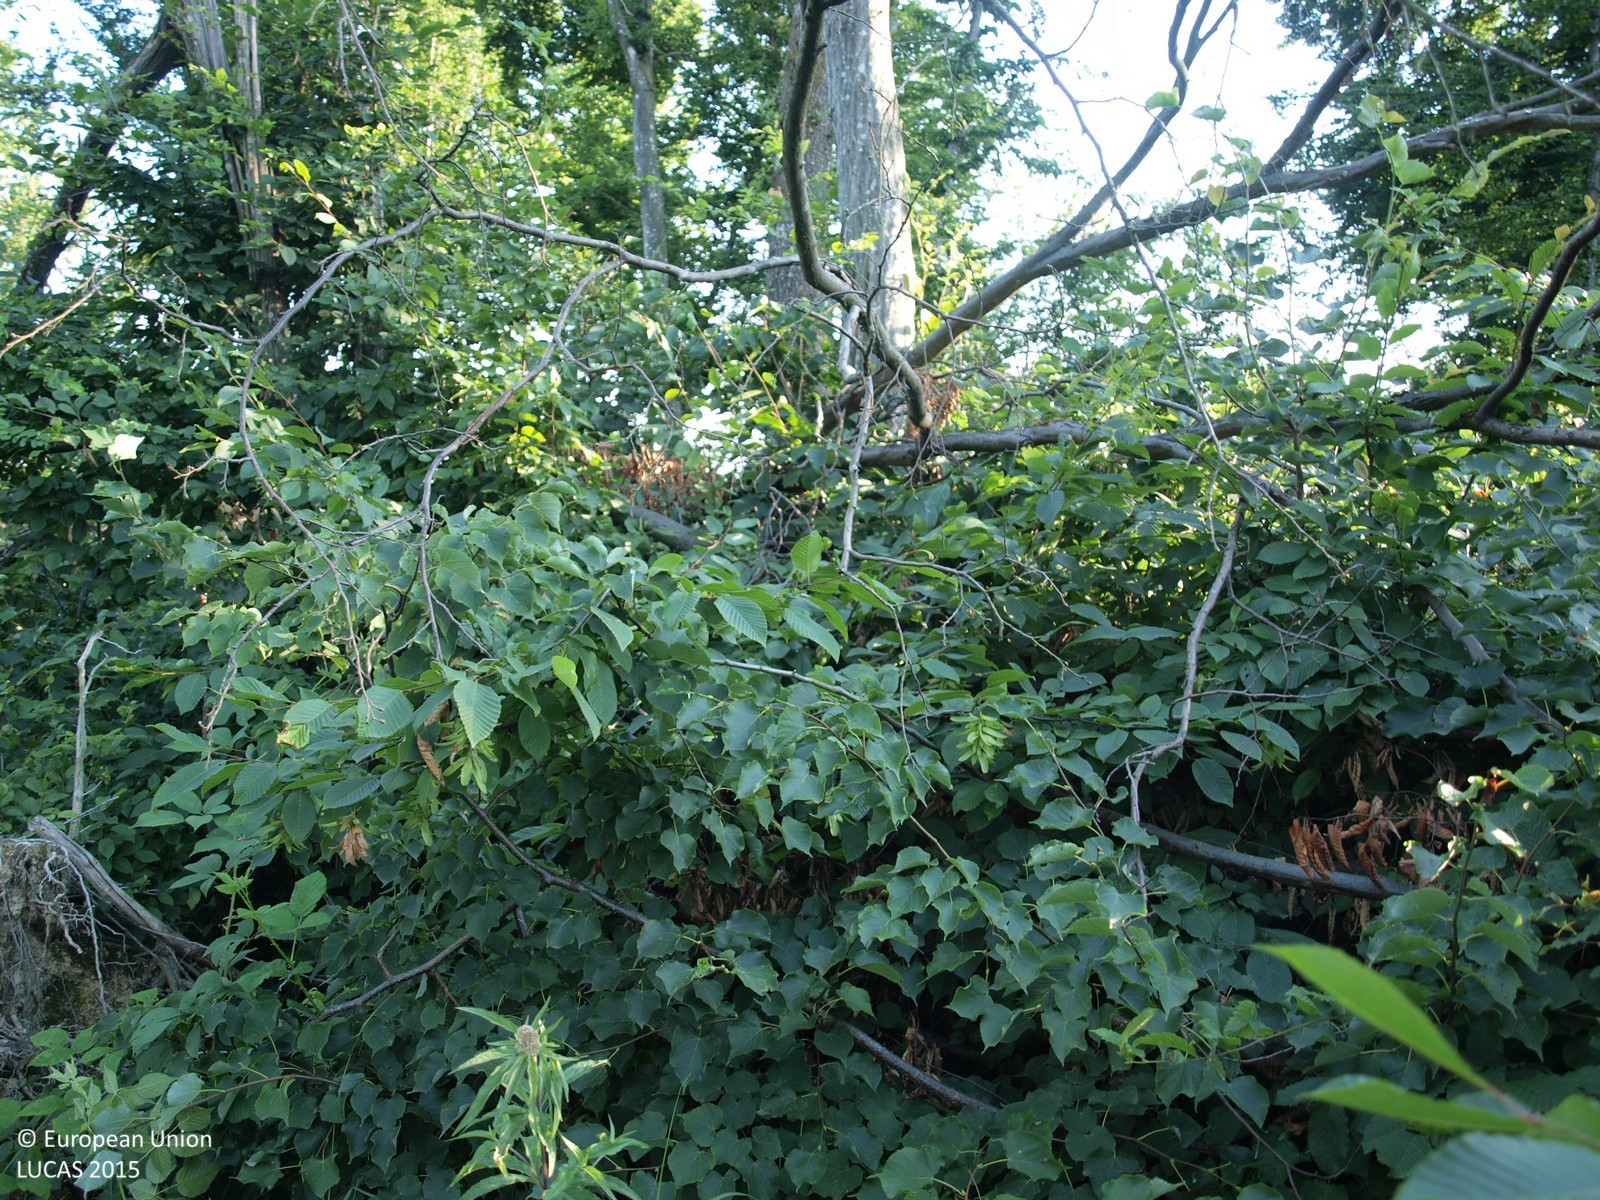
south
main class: Woodland
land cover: Broadleaved woodland
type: mesophytic deciduous forest
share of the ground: > 75 %
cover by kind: broadleaved forest trees 90 %, shrubs 10 %
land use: Forestry
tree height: > 5 m
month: July
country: HR
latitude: 45.6791
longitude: 15.6329
